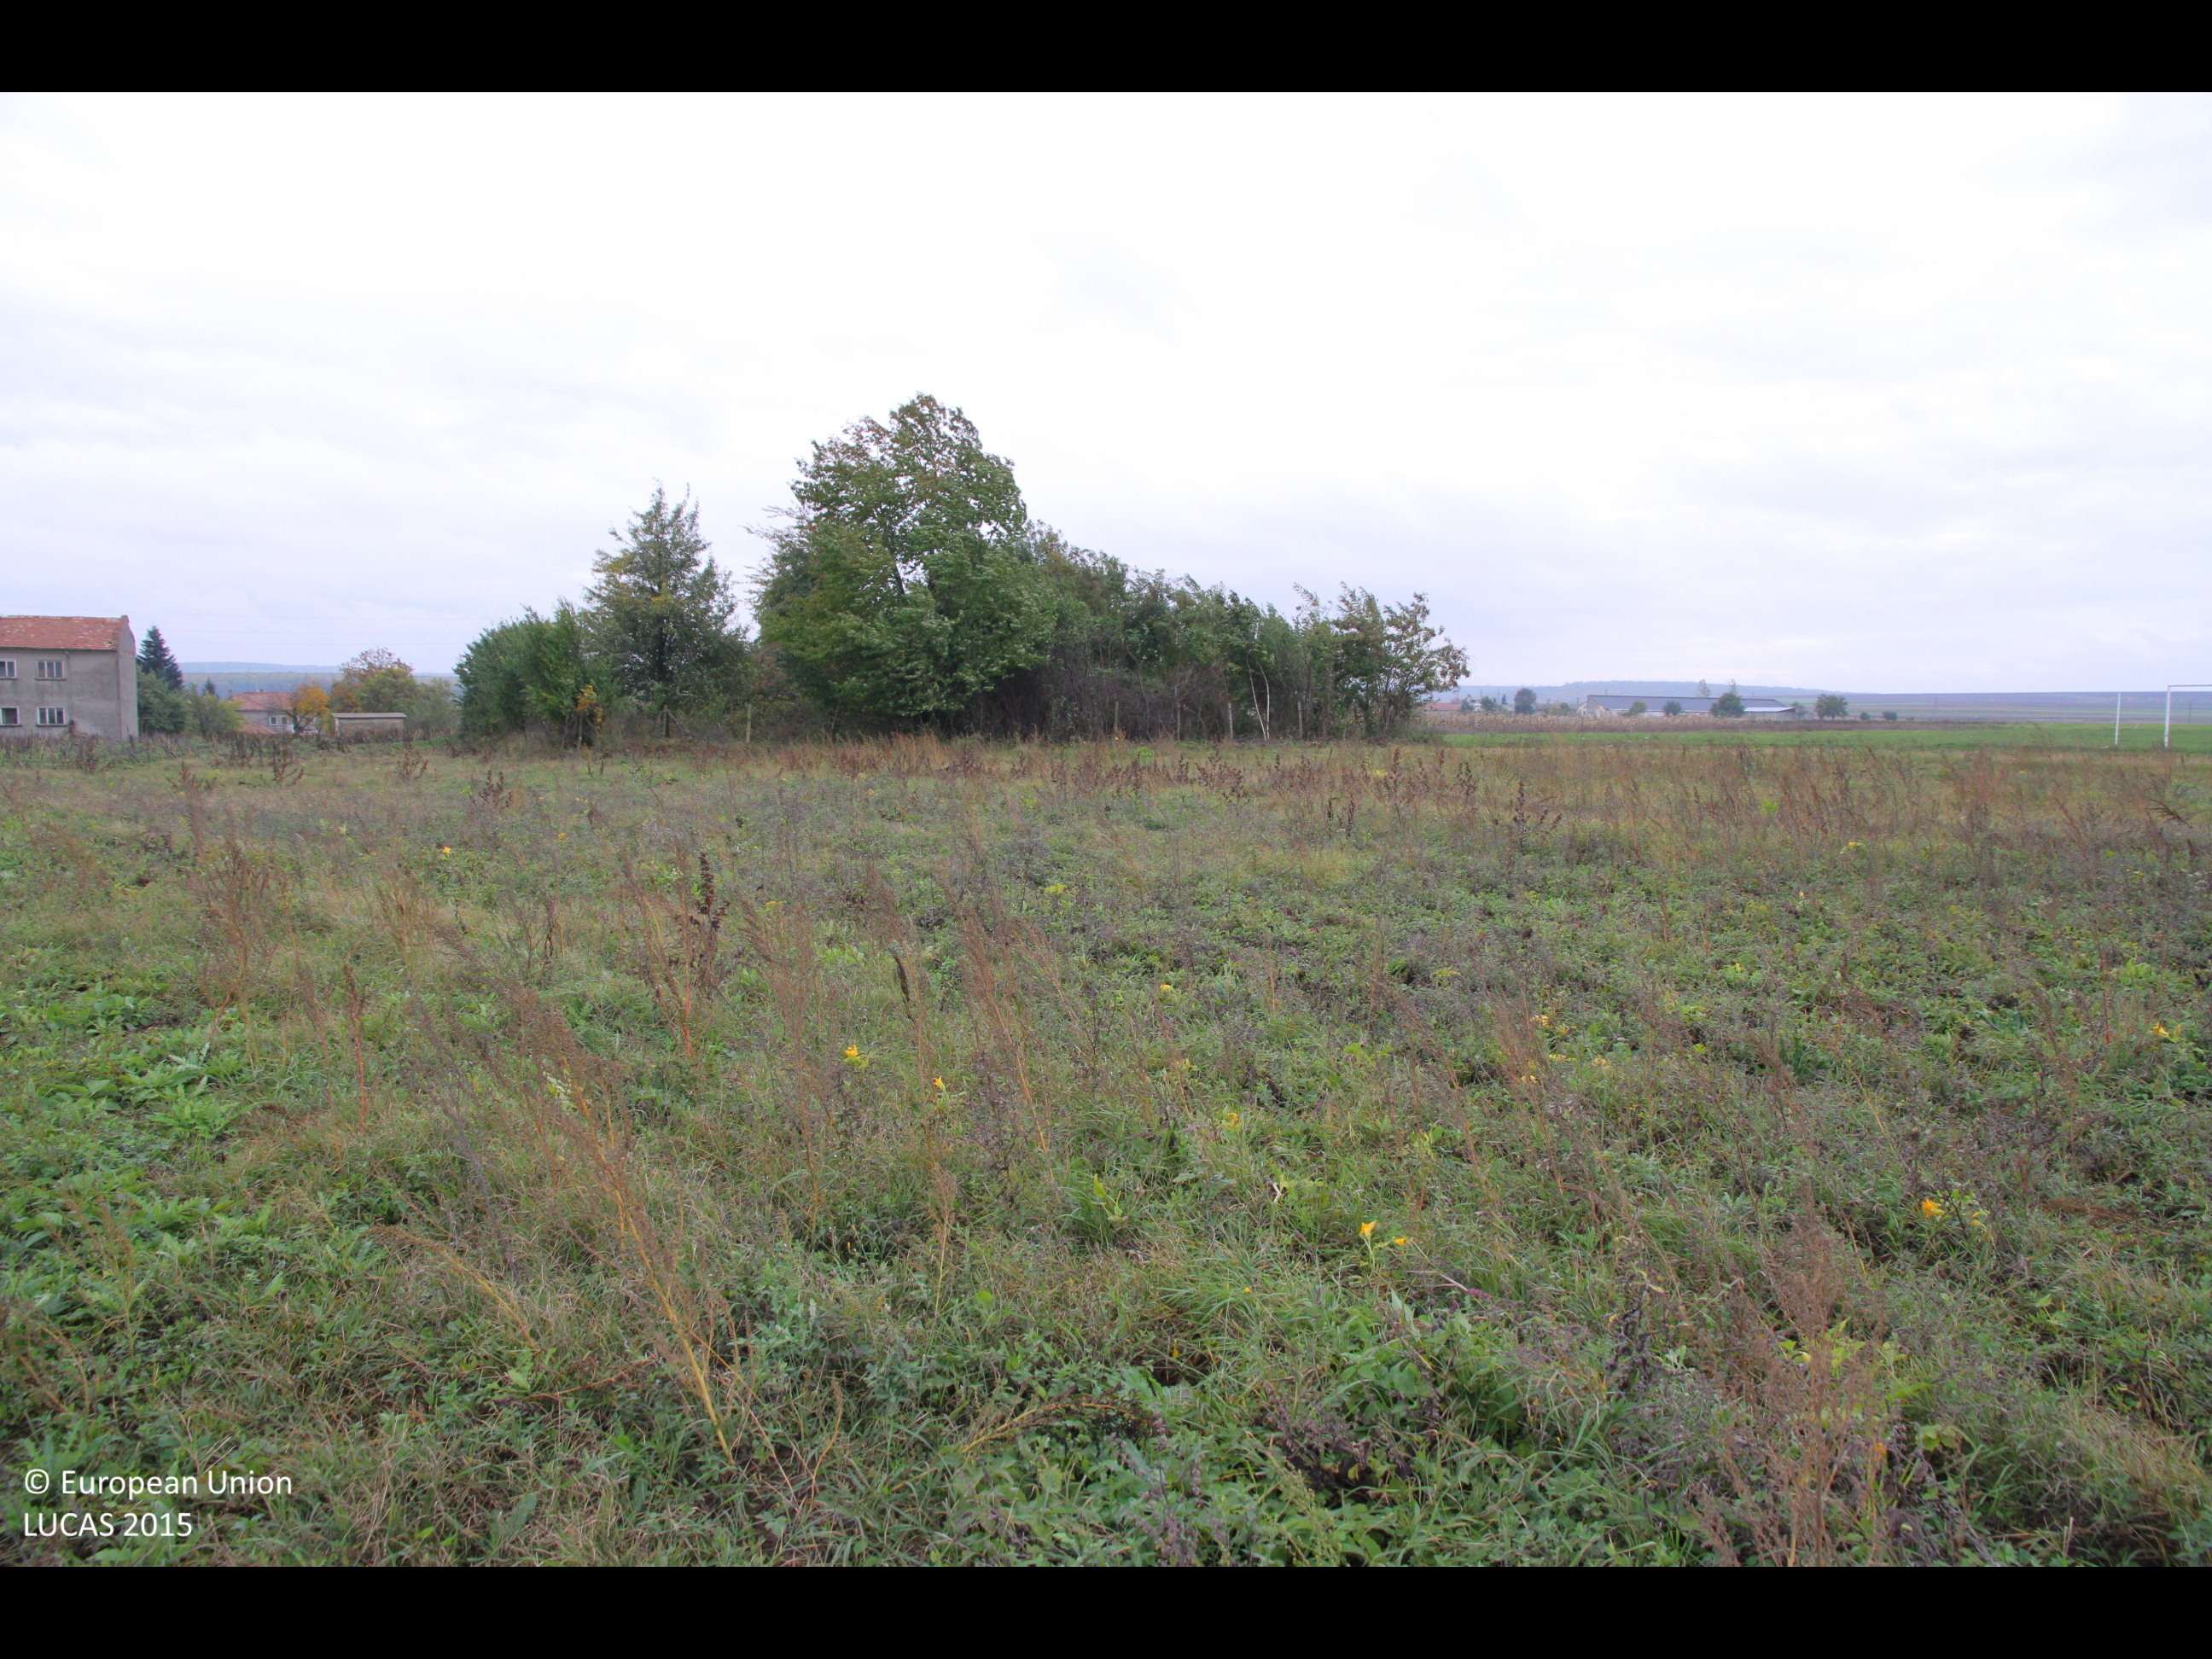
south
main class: Cropland
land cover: Other fresh vegetables
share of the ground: 10 - 25 %
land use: Agriculture (excluding fallow land and kitchen gardens)
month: October
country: BG
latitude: 43.5434
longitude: 26.8849
